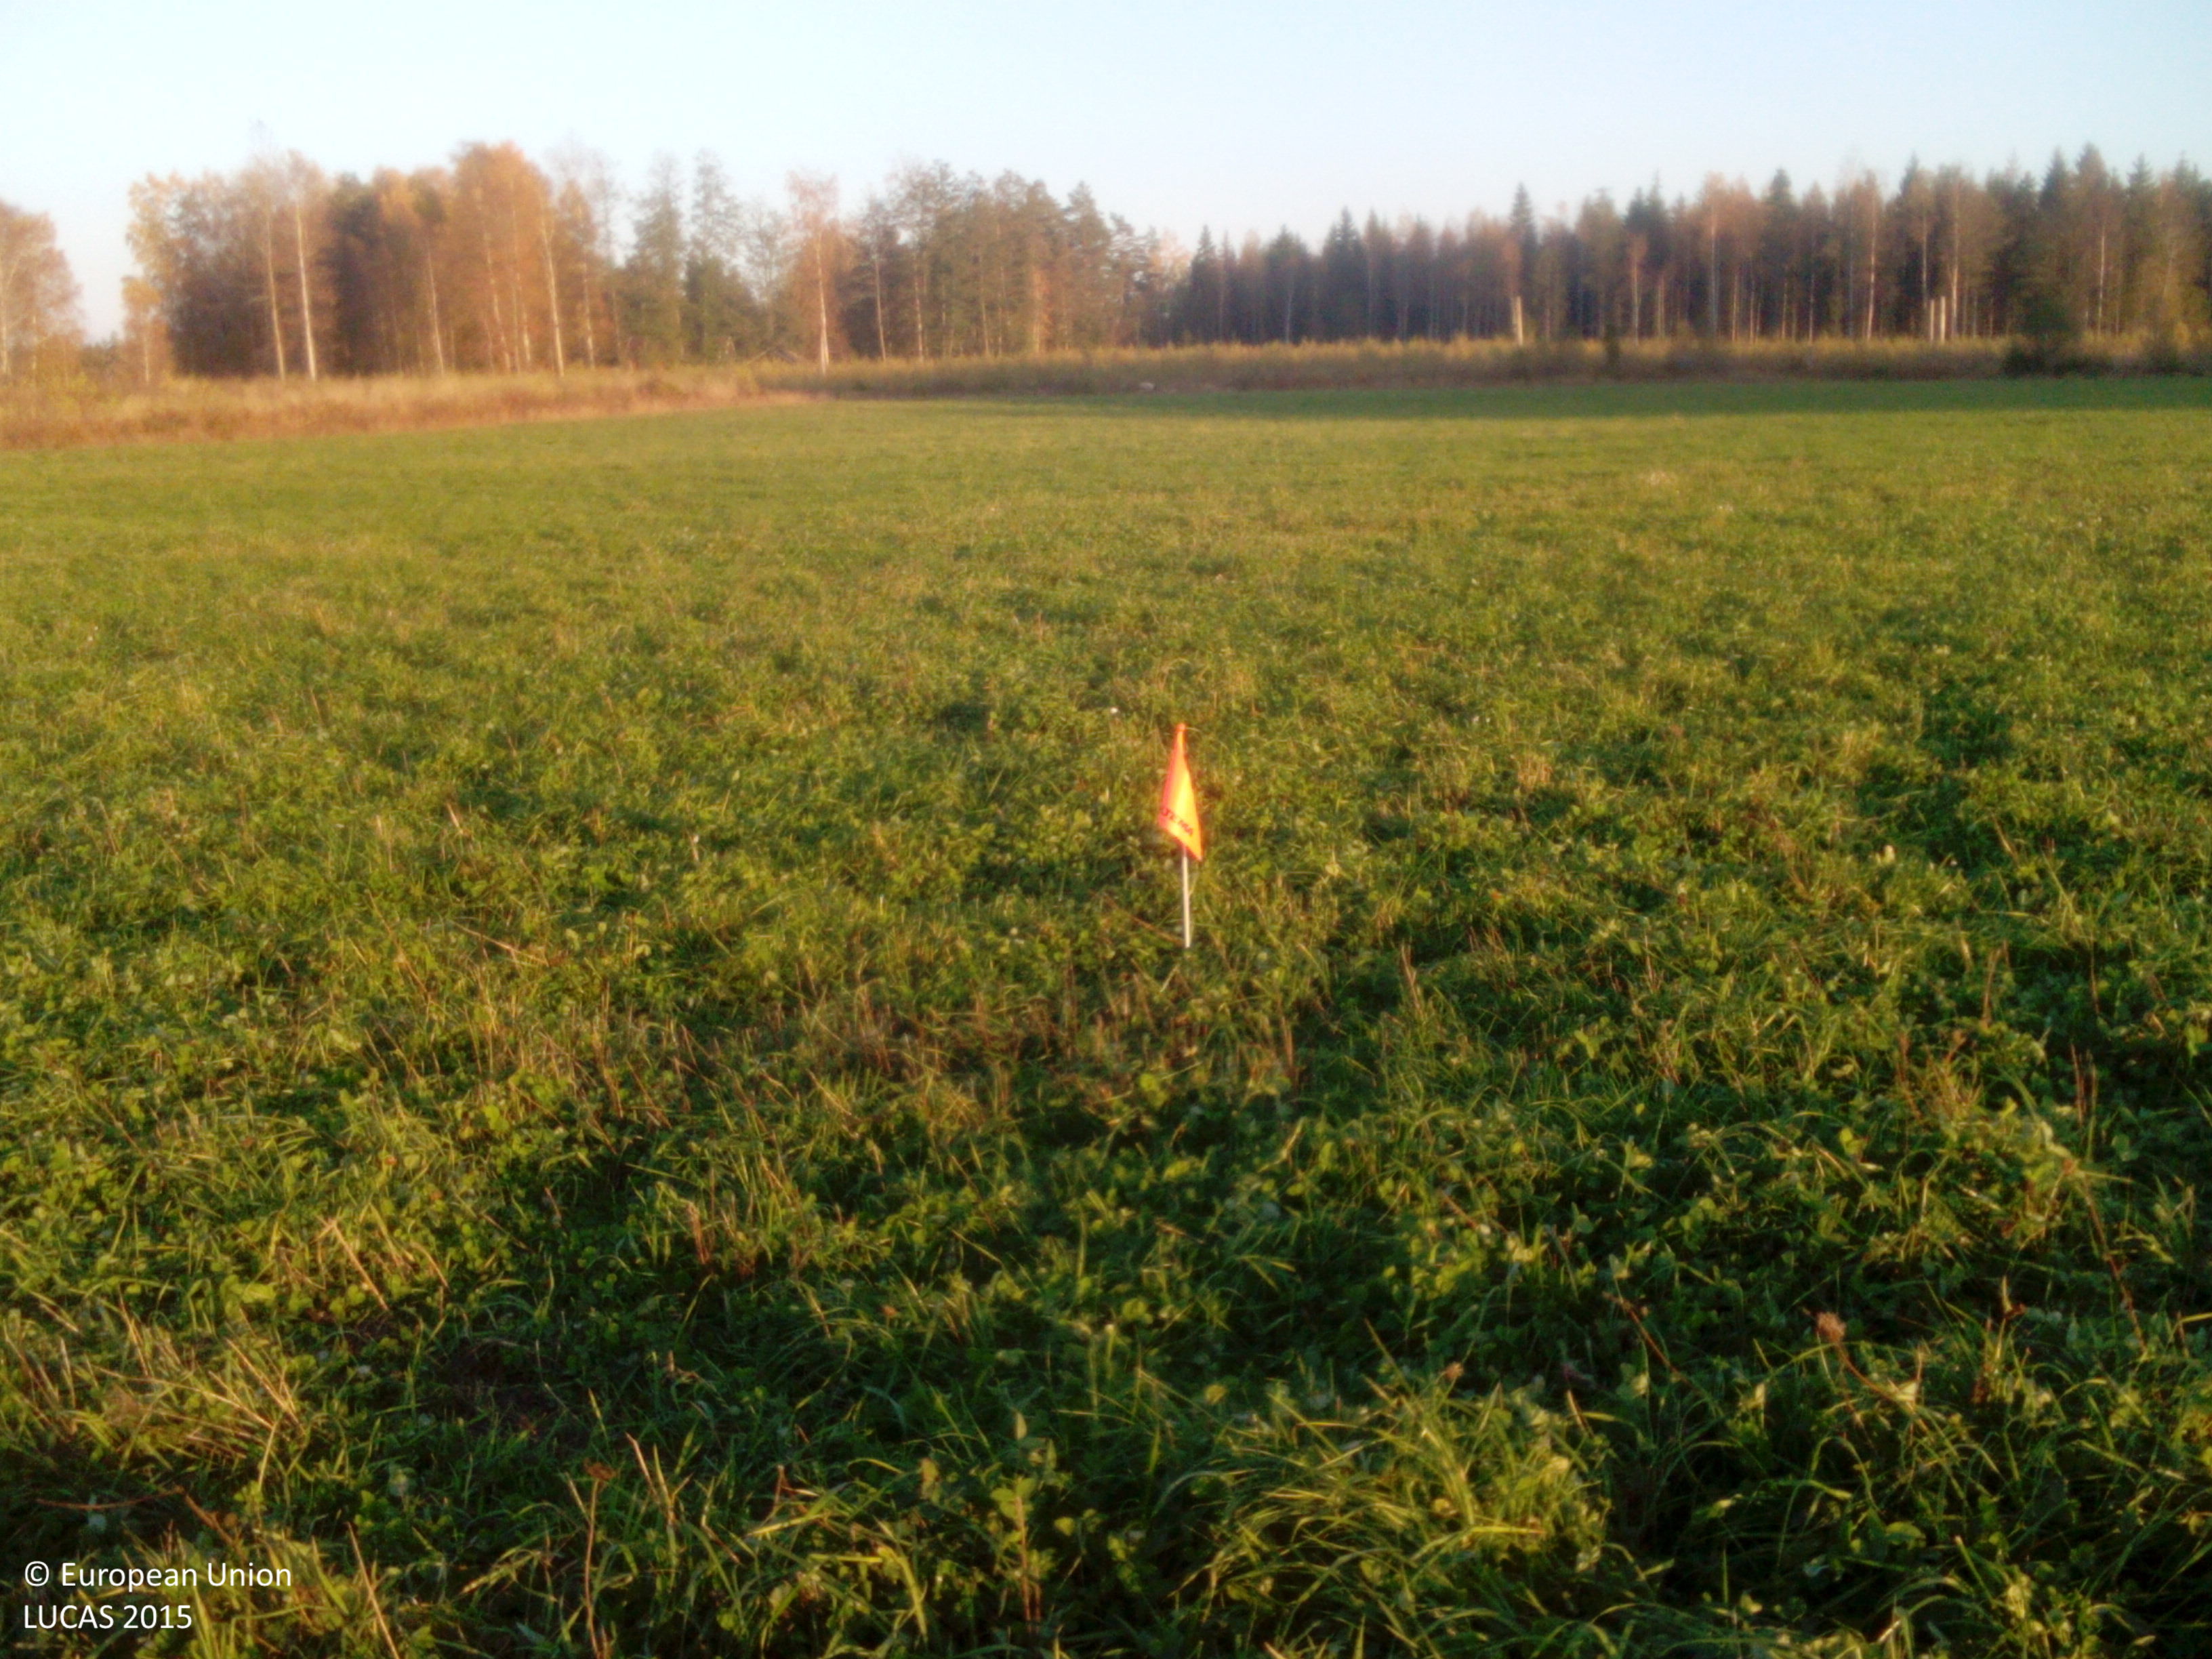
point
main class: Cropland
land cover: Clovers
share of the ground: > 75 %
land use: Agriculture (excluding fallow land and kitchen gardens)
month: October
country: SE
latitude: 58.8797
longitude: 16.3956
